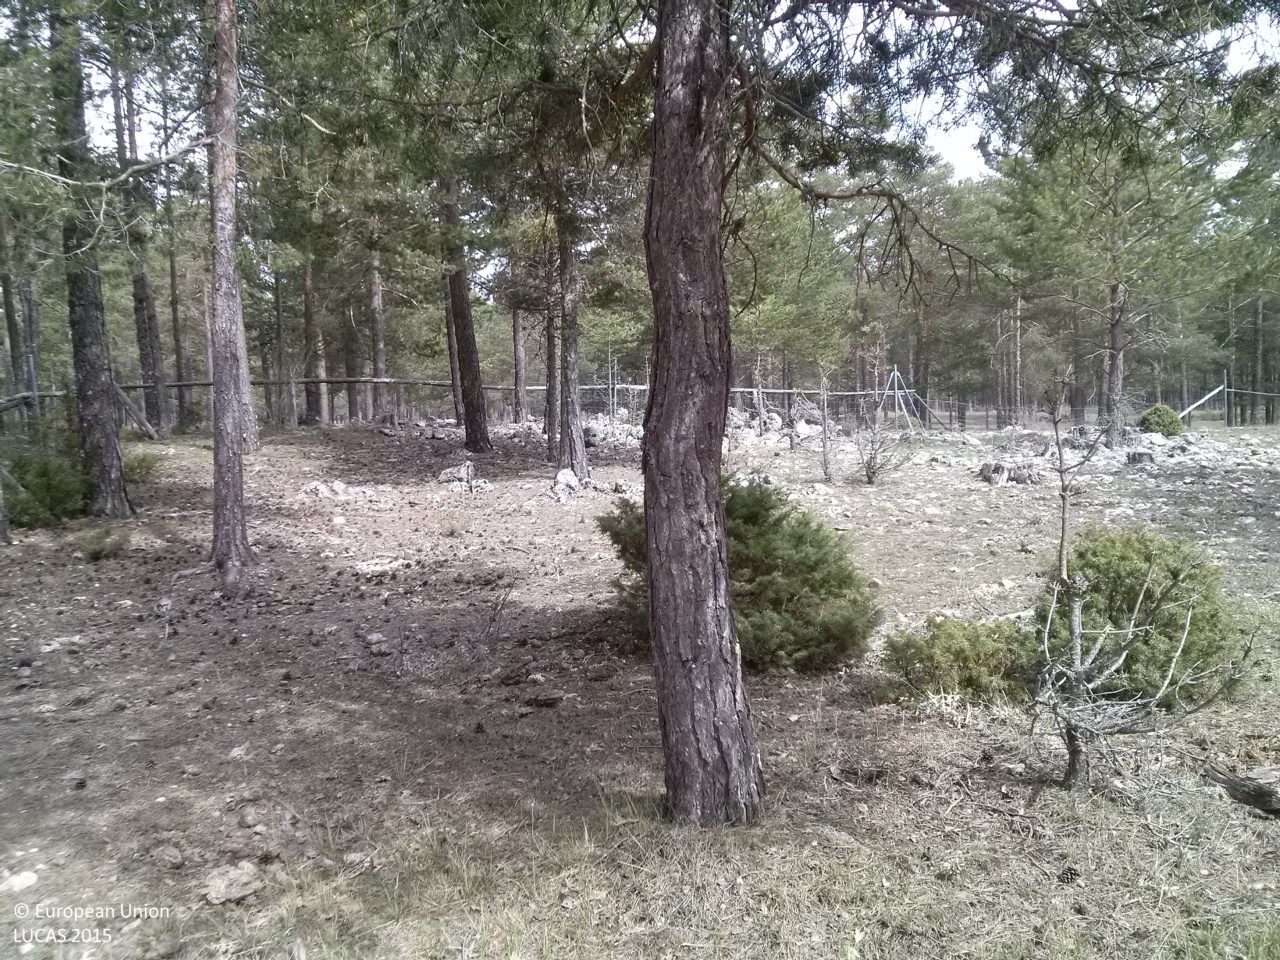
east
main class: Woodland
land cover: Pine dominated coniferous woodland
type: coniferous forest of the mediterranean region
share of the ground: 50 - 75 %
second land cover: Grassland without tree/shrub cover
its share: > 75 %
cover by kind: coniferous forest trees 50 %, herbaceous plants 50 %
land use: Forestry
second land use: Agriculture (excluding fallow land and kitchen gardens)
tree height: > 5 m
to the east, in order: Pine dominated coniferous woodland; Grassland without tree/shrub cover; Fences; Pine dominated coniferous woodland; Tracks; Pine dominated coniferous woodland; Rock outcrops; Pine dominated coniferous woodland
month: April
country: ES
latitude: 40.2882
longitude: -1.9085
